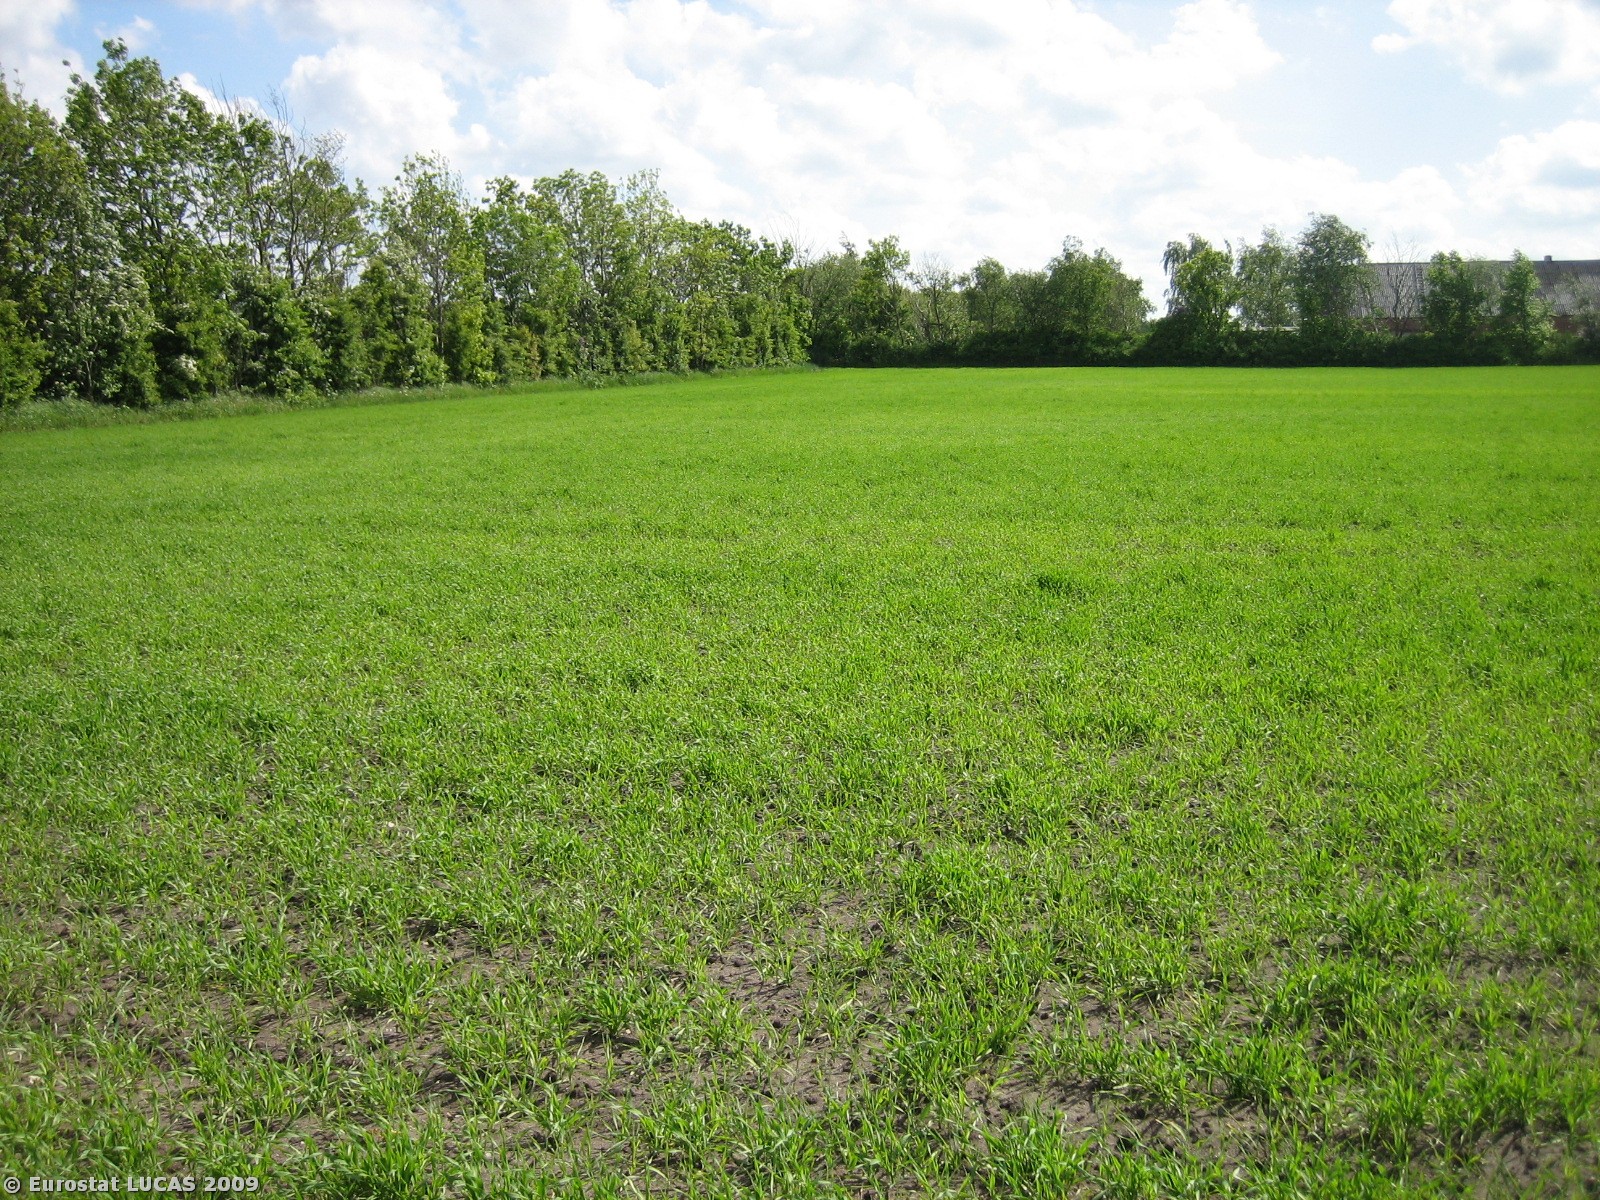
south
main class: Cropland
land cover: Barley
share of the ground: 50 - 75 %
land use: Agriculture (excluding fallow land and kitchen gardens)
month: May
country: DK
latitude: 56.2736
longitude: 8.9838
